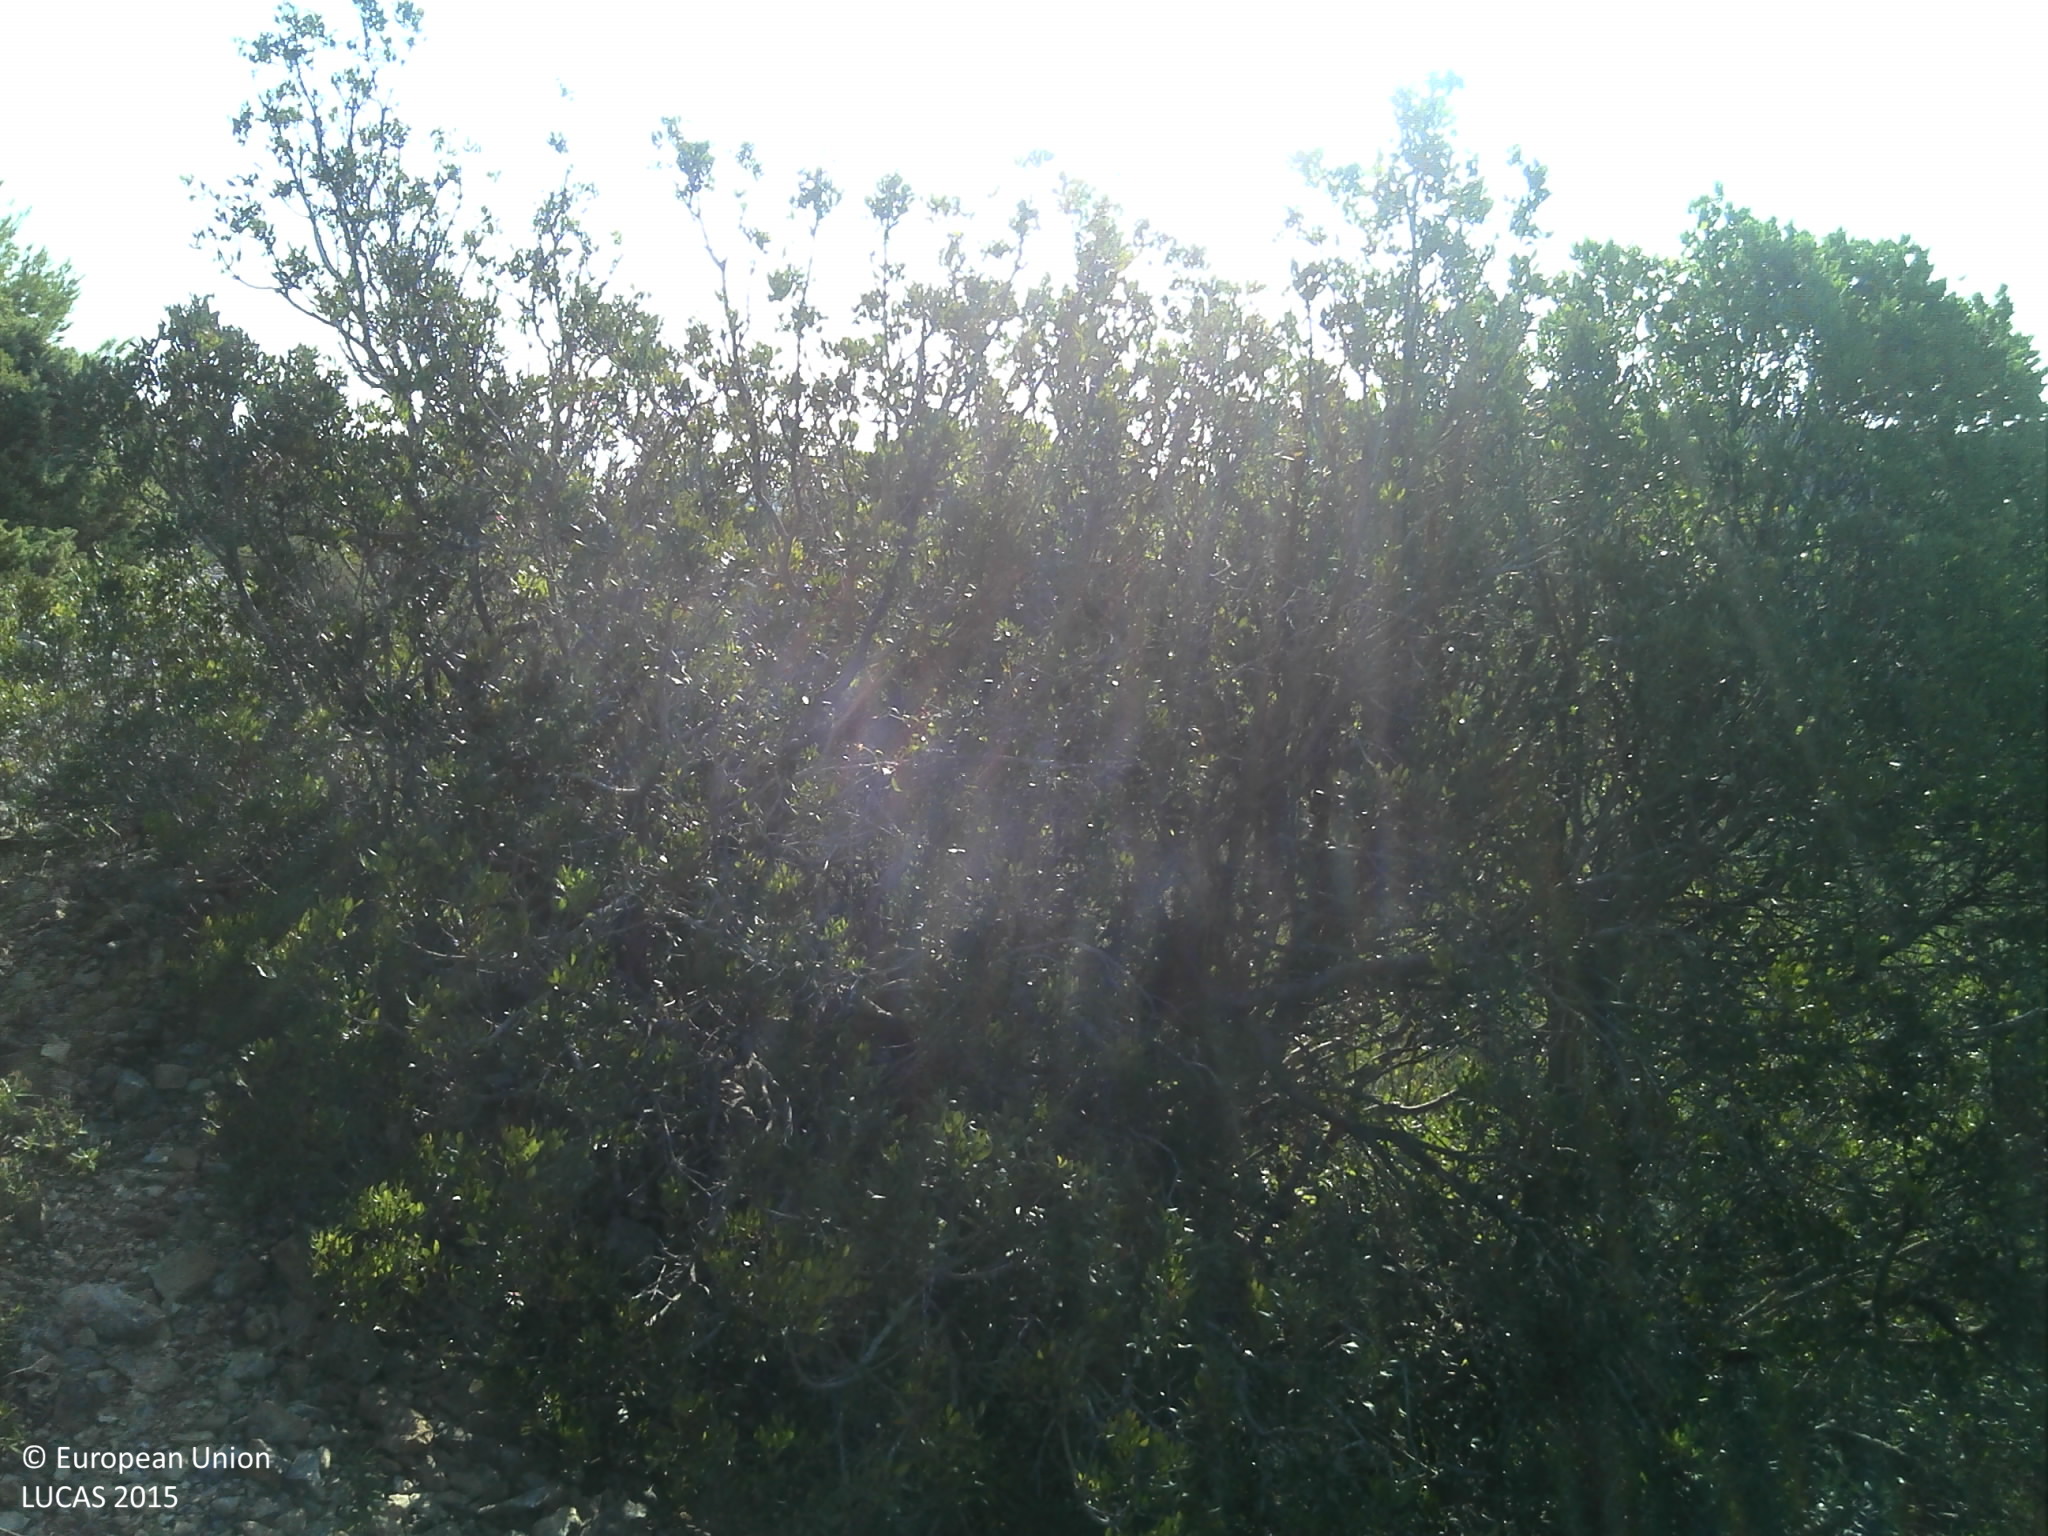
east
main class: Shrubland
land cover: Shrubland with sparse tree cover
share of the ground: > 75 %
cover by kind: shrubs 60 %, unconsolidated bare surface 20 %, herbaceous plants 10 %, coniferous forest trees 5 %, consolidated bare surface 5 %
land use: Abandoned areas
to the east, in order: Shrubland with sparse tree cover; Dry stone walls; Shrubland with sparse tree cover; Dry stone walls; Shrubland with sparse tree cover; Dry stone walls; Shrubland with sparse tree cover; Dry stone walls; Shrubland with sparse tree cover; Dry stone walls; Shrubland with sparse tree cover; Grassland with sparse tree/shrub cover; Artificial constructions in urban areas; Grassland with sparse tree/shrub cover
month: August
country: HR
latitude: 43.0456
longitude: 16.1633
